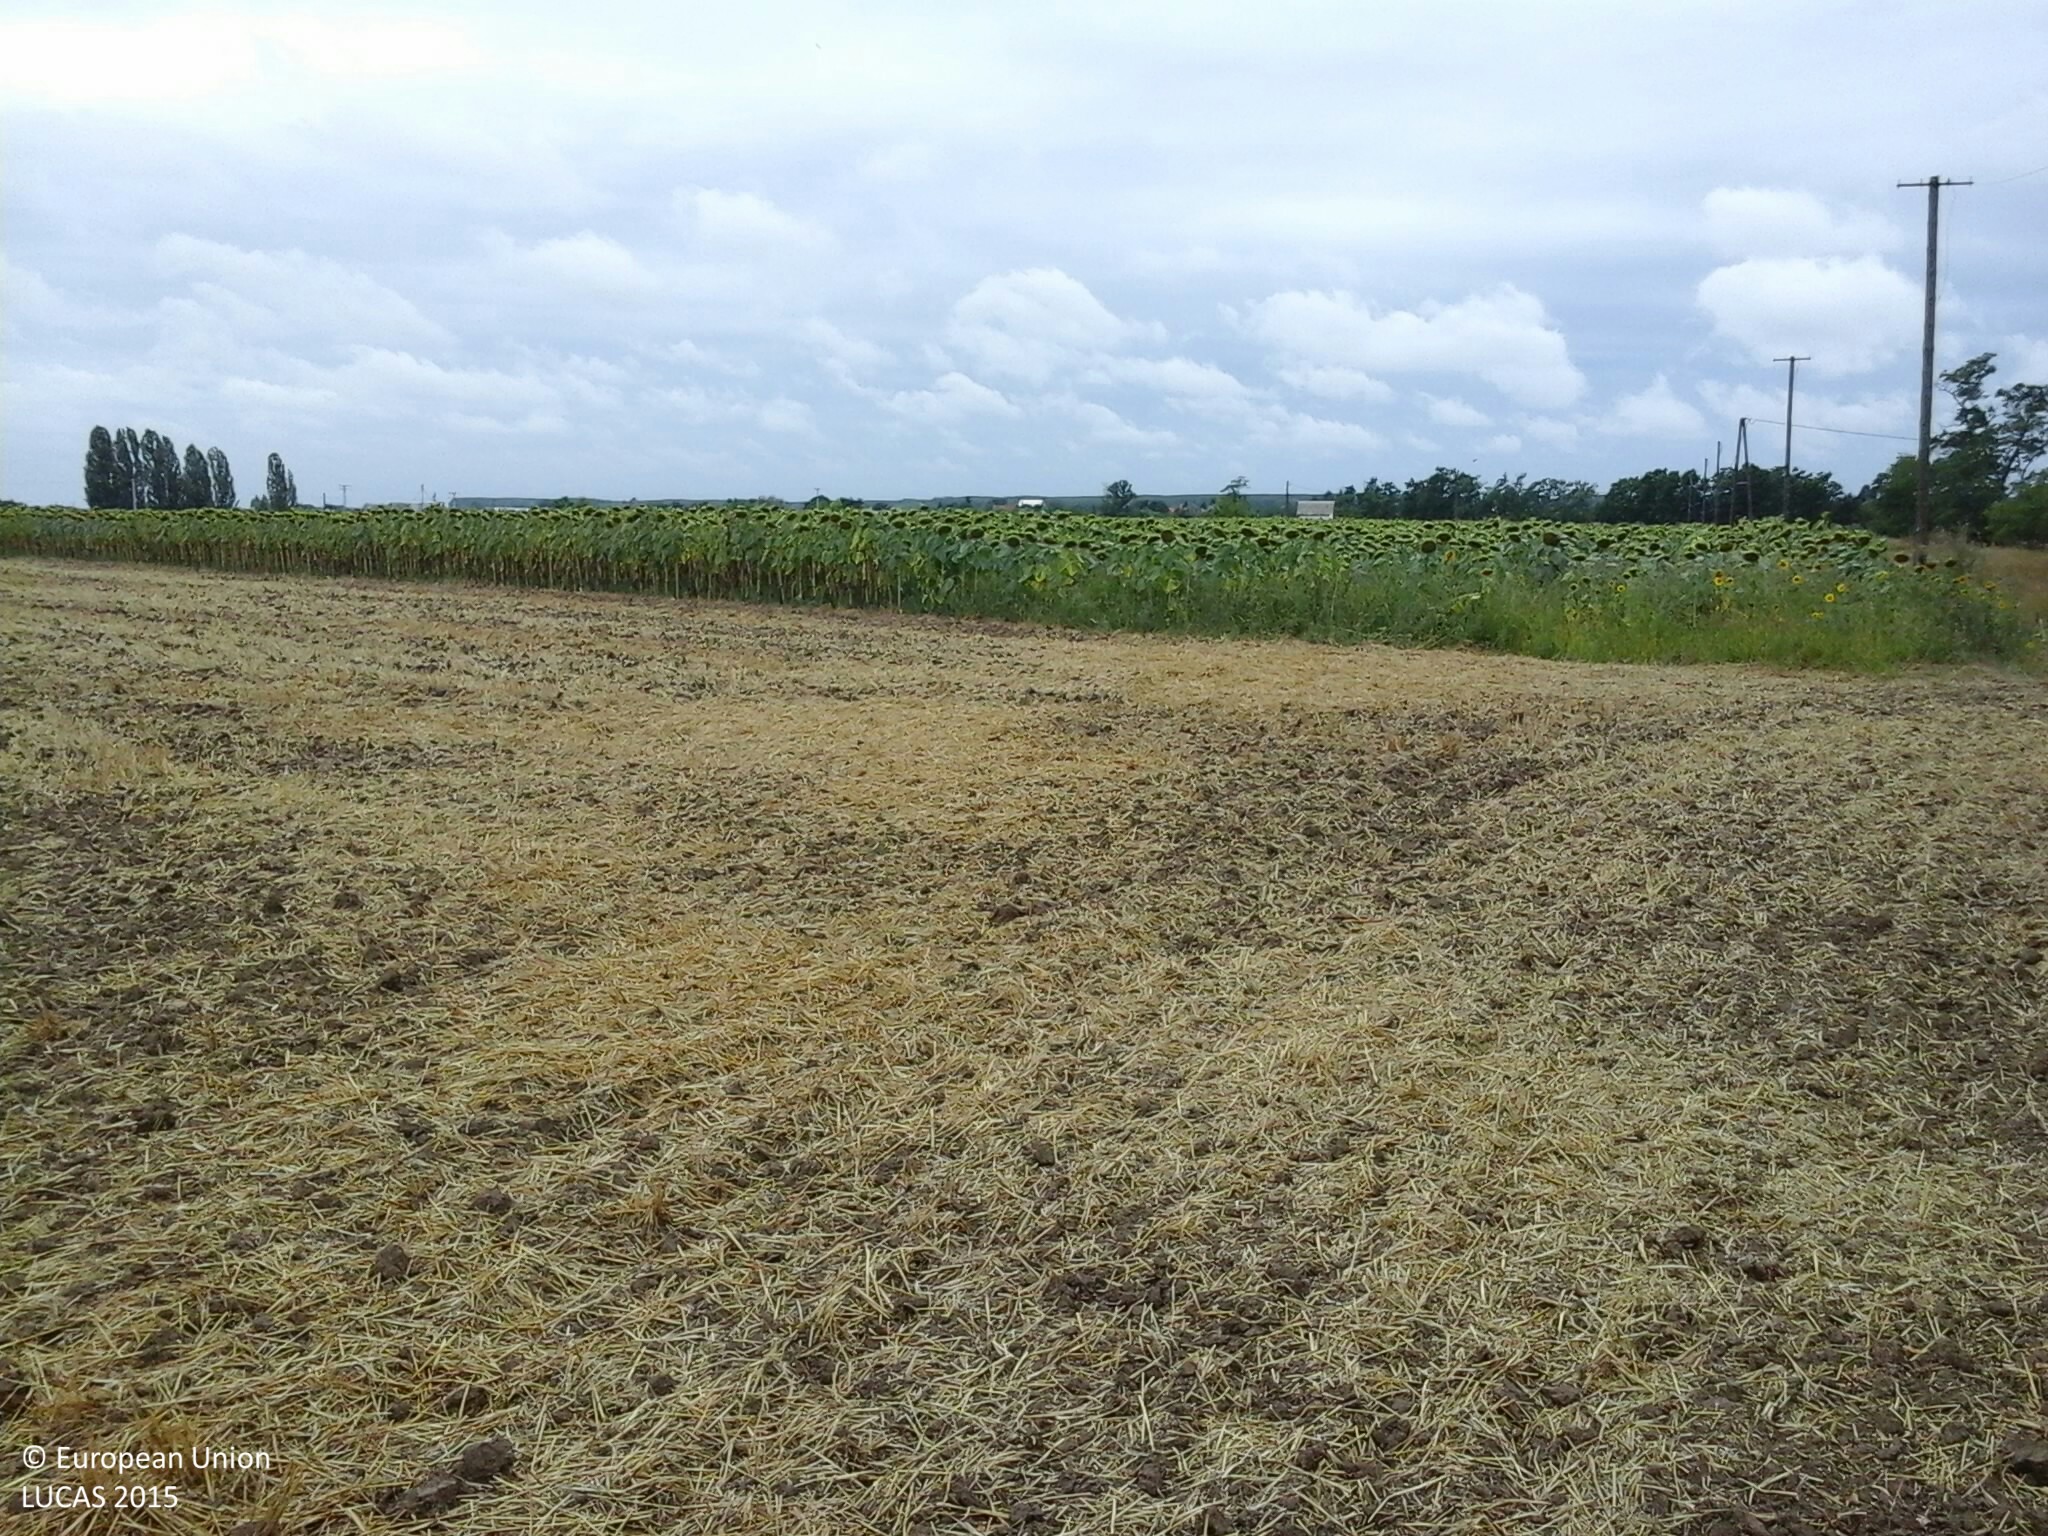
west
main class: Cropland
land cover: Triticale
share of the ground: 25 - 50 %
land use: Agriculture (excluding fallow land and kitchen gardens)
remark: Harvested field
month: July
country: HU
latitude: 46.8840
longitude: 20.1424
